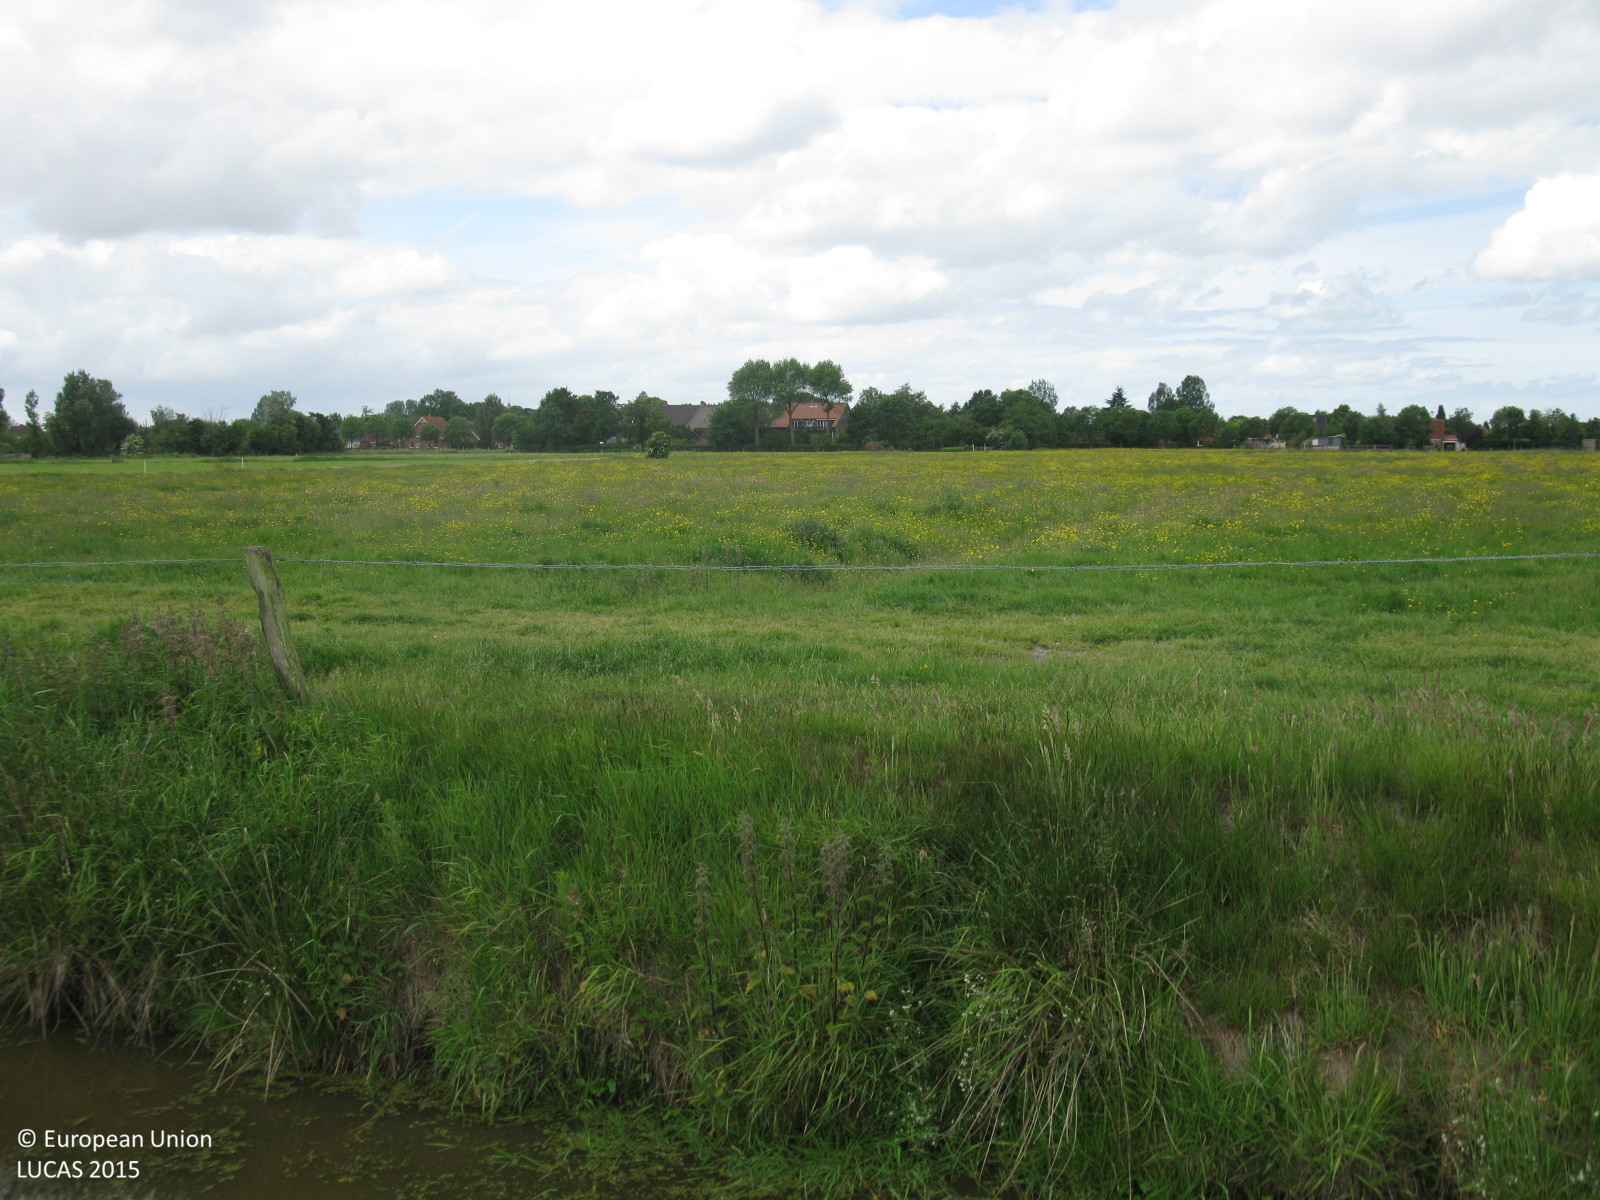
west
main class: Grassland
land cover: Grassland without tree/shrub cover
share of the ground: > 75 %
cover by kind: herbaceous plants 100 %
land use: Agriculture (excluding fallow land and kitchen gardens)
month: June
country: DE
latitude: 53.3355
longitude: 7.2824
